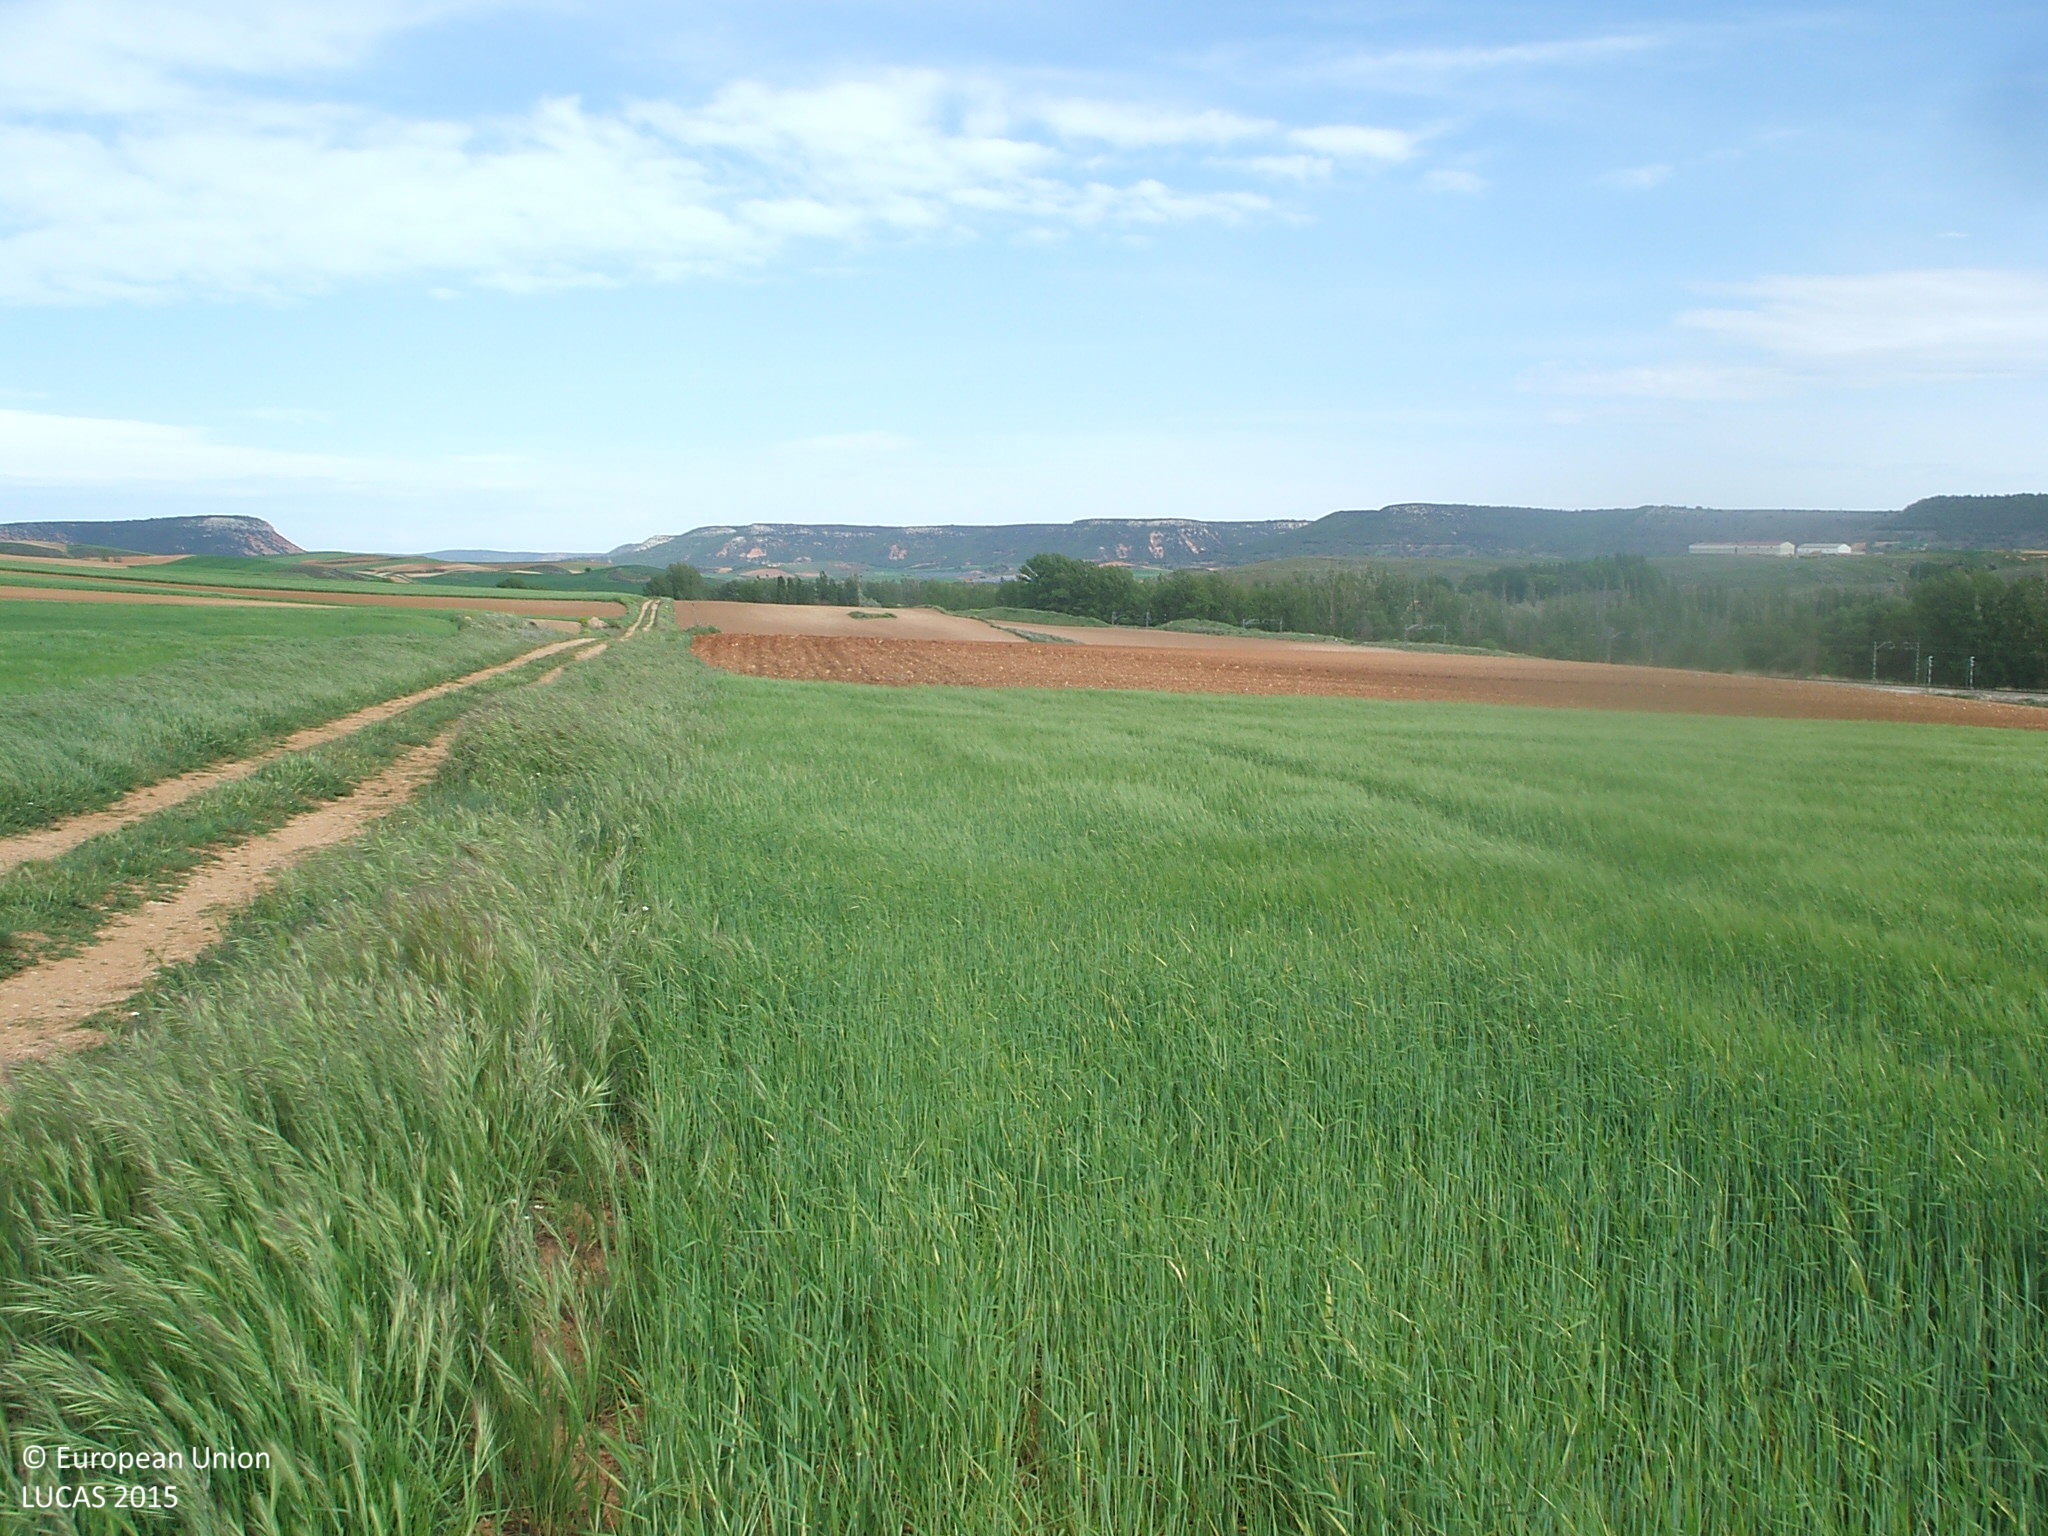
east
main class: Cropland
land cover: Barley
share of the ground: > 75 %
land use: Agriculture (excluding fallow land and kitchen gardens)
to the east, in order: Barley; Grass margins; Tracks; Grass margins; Grassland without tree/shrub cover
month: May
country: ES
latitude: 40.9483
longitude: -2.8992
